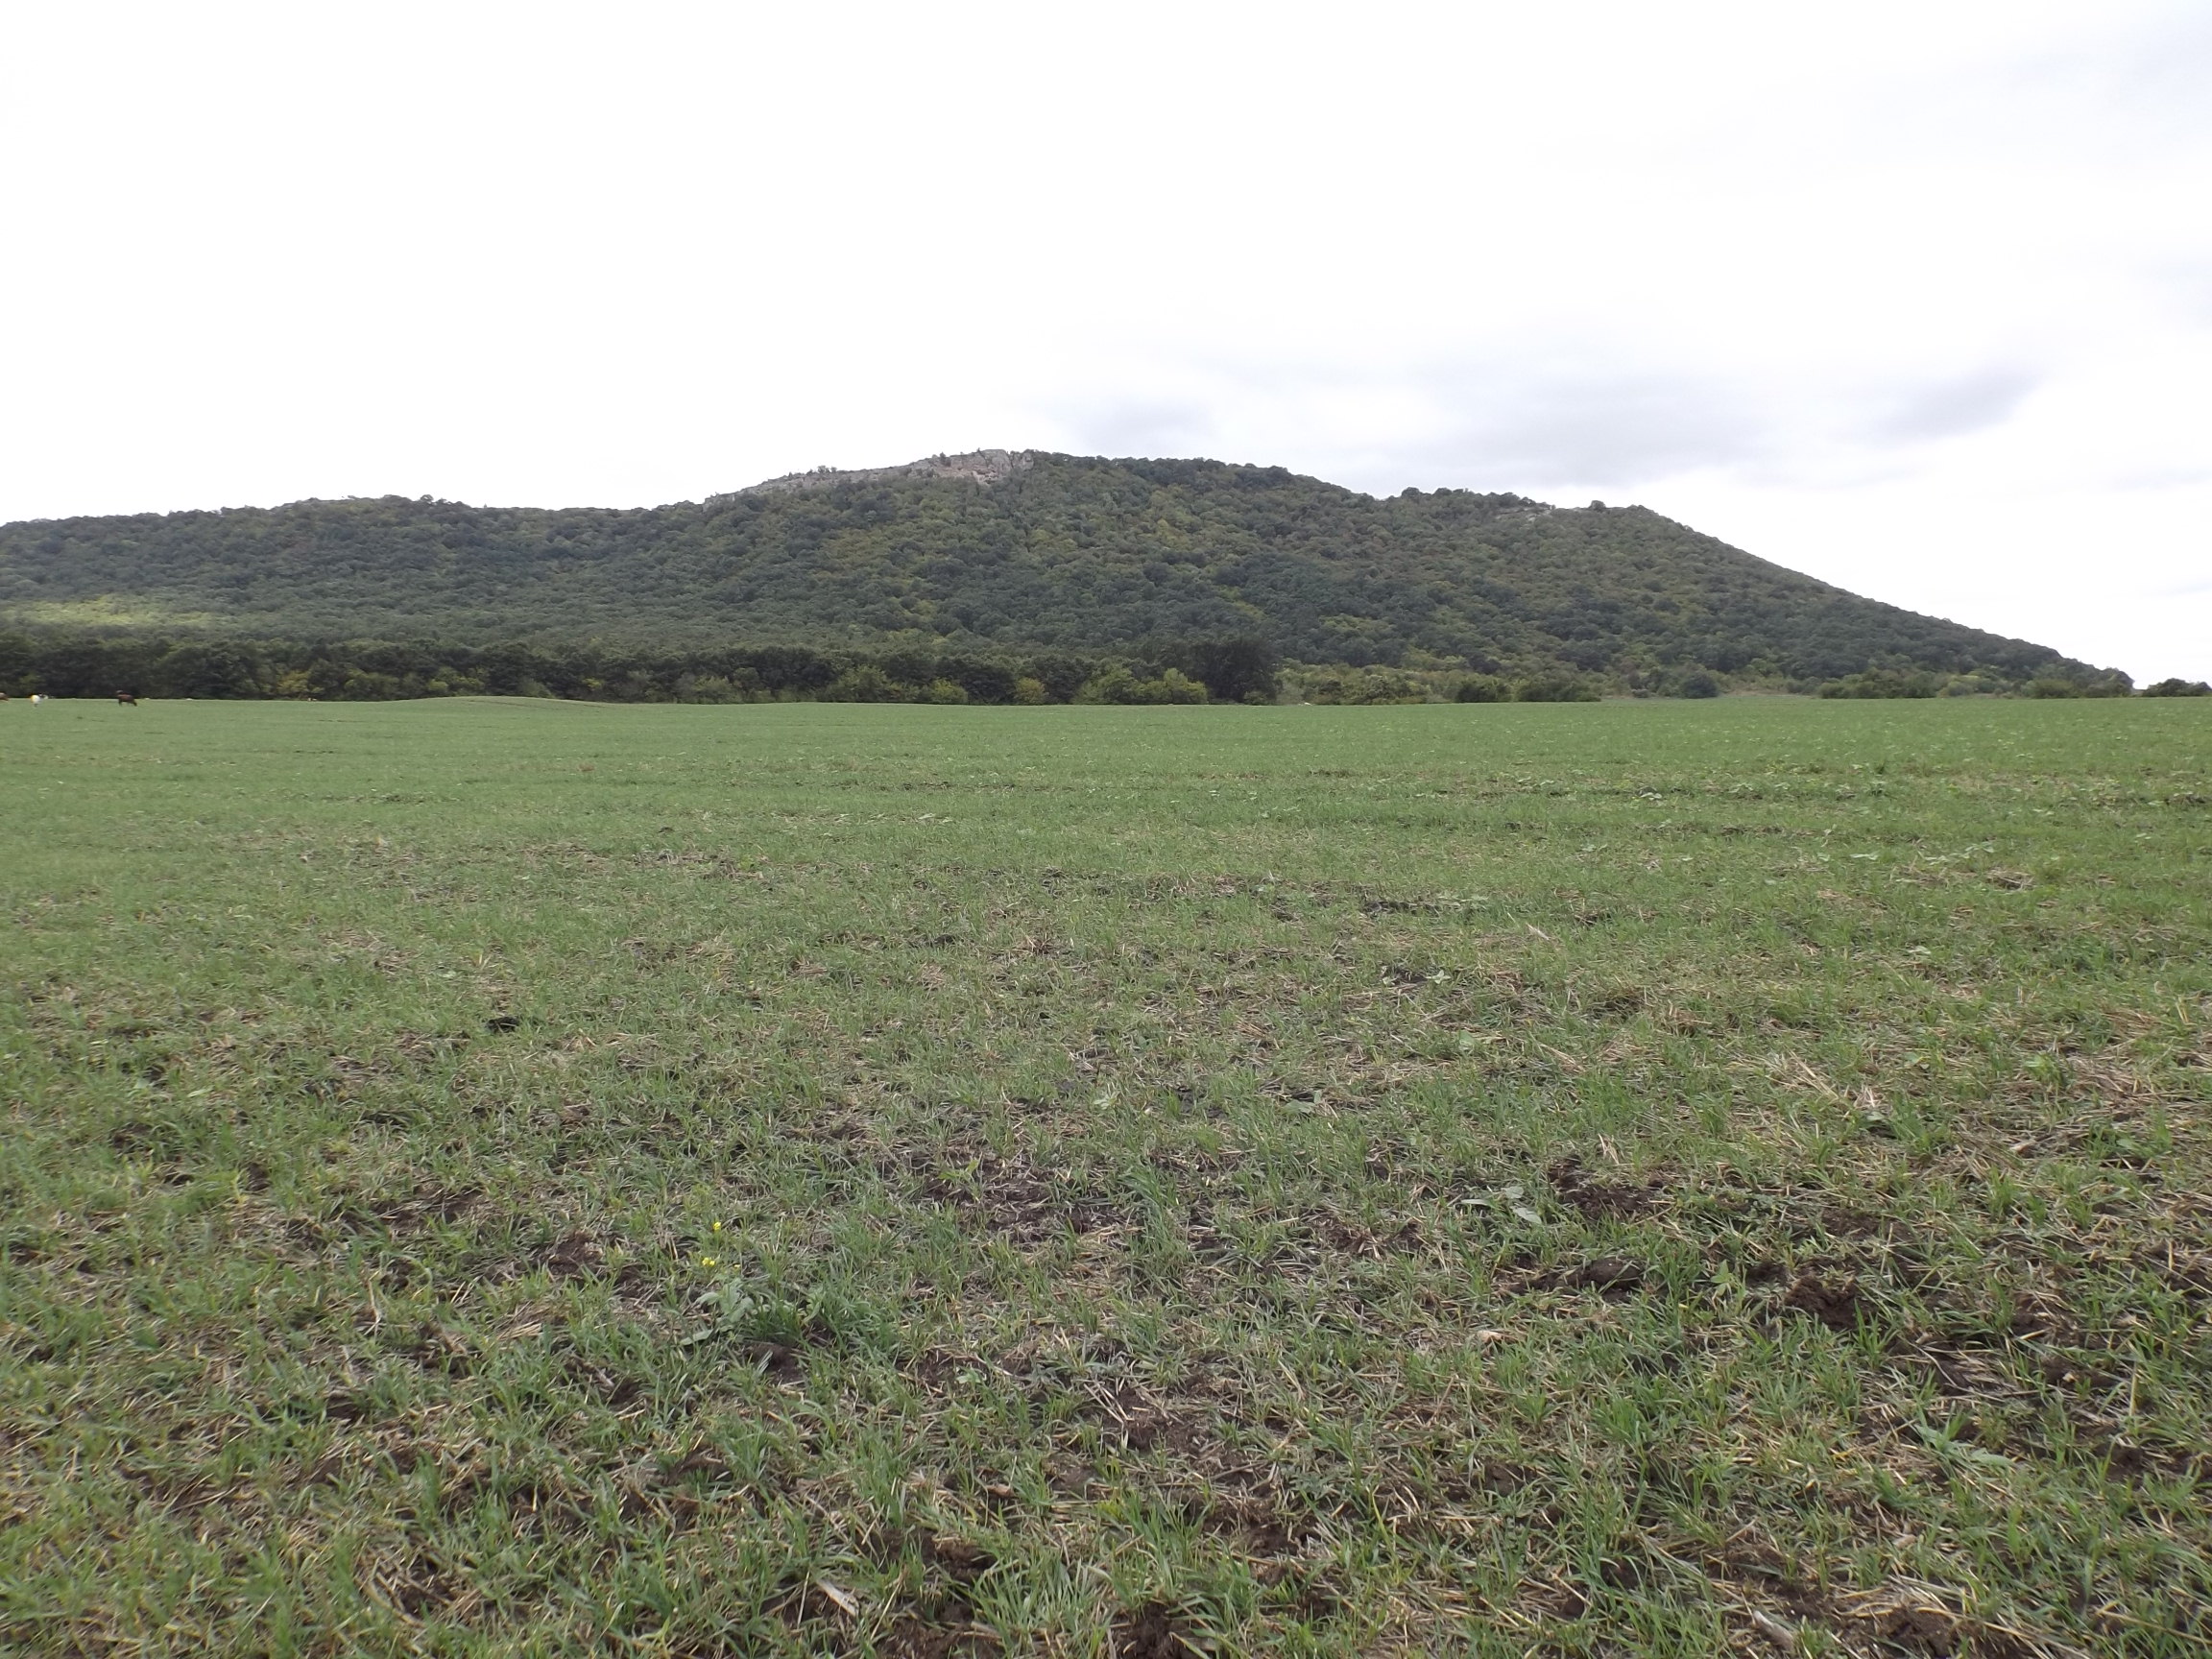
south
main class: Cropland
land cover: Common wheat
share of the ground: < 10 %
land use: Agriculture (excluding fallow land and kitchen gardens)
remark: Harvested field
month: September
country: BG
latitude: 43.0957
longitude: 27.4600
